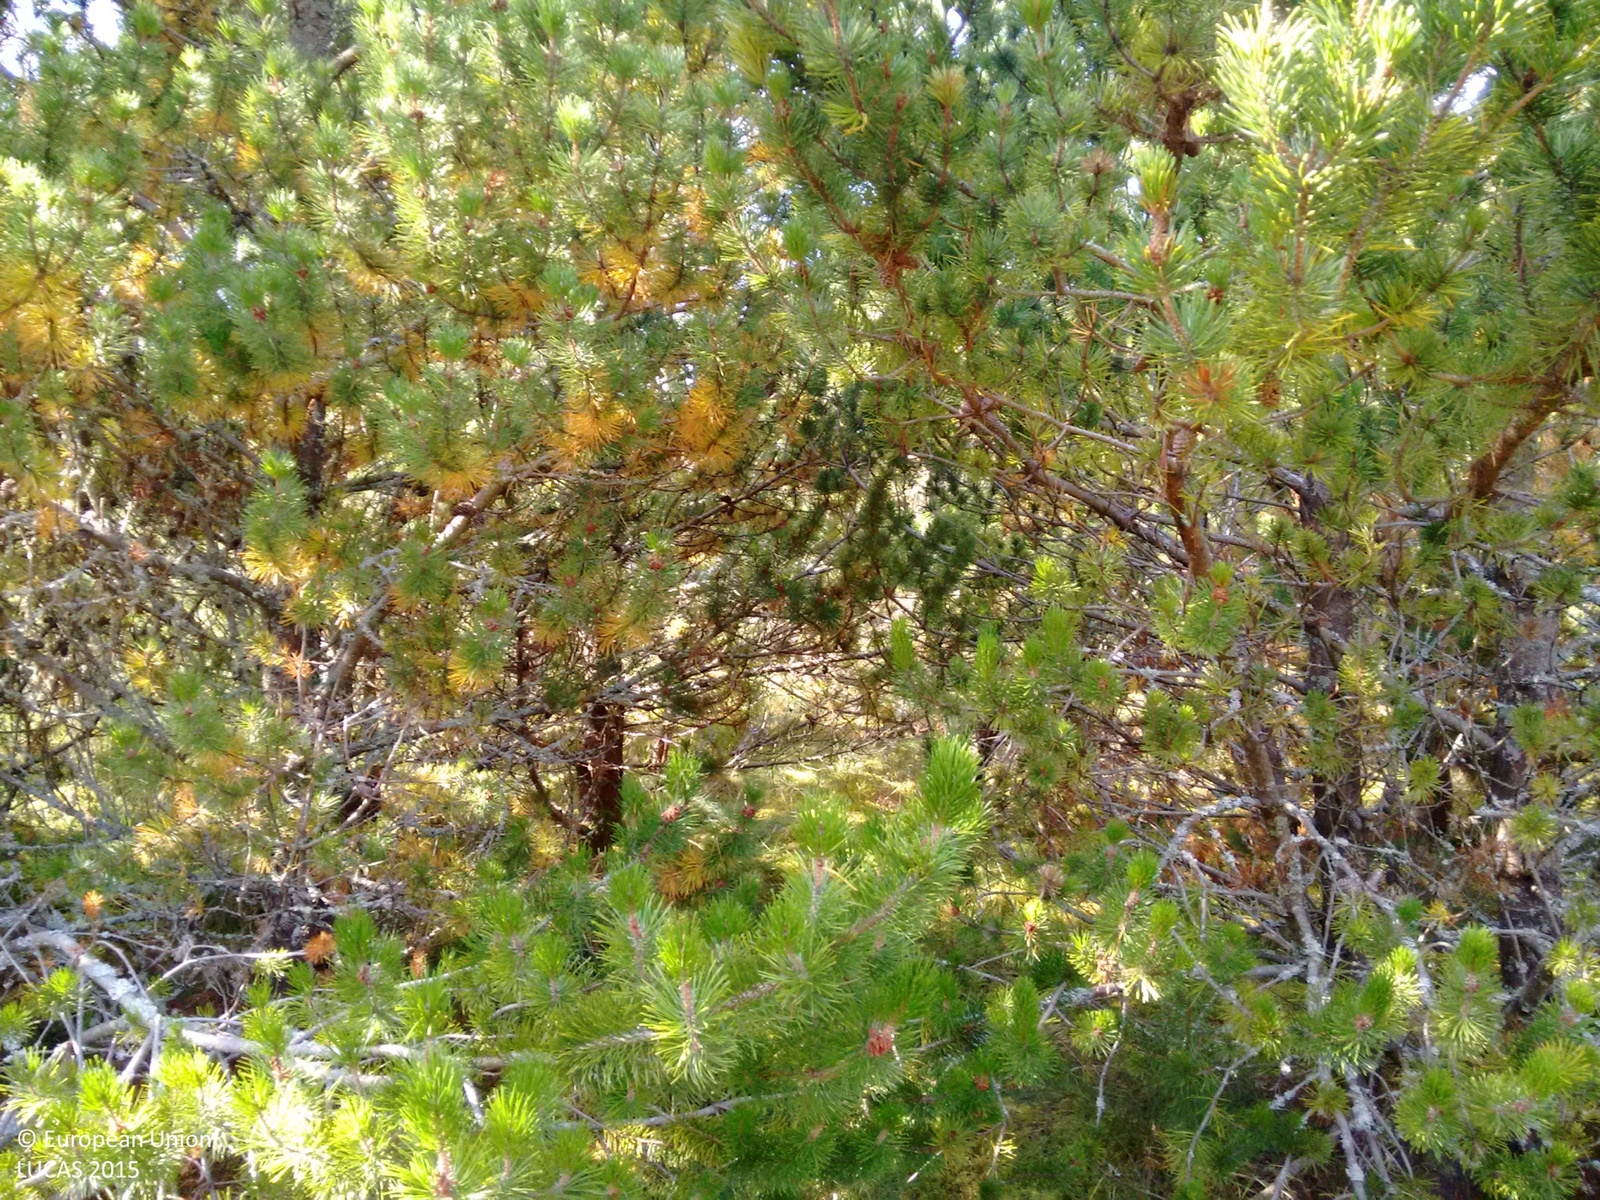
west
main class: Woodland
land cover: Pine dominated mixed woodland
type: exotic forest
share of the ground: > 75 %
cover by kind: coniferous forest trees 45 %, herbaceous plants 30 %, broadleaved forest trees 15 %, lichens and mosses 10 %
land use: Forestry
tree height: > 5 m
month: September
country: GB
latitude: 58.0779
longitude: -4.4137
